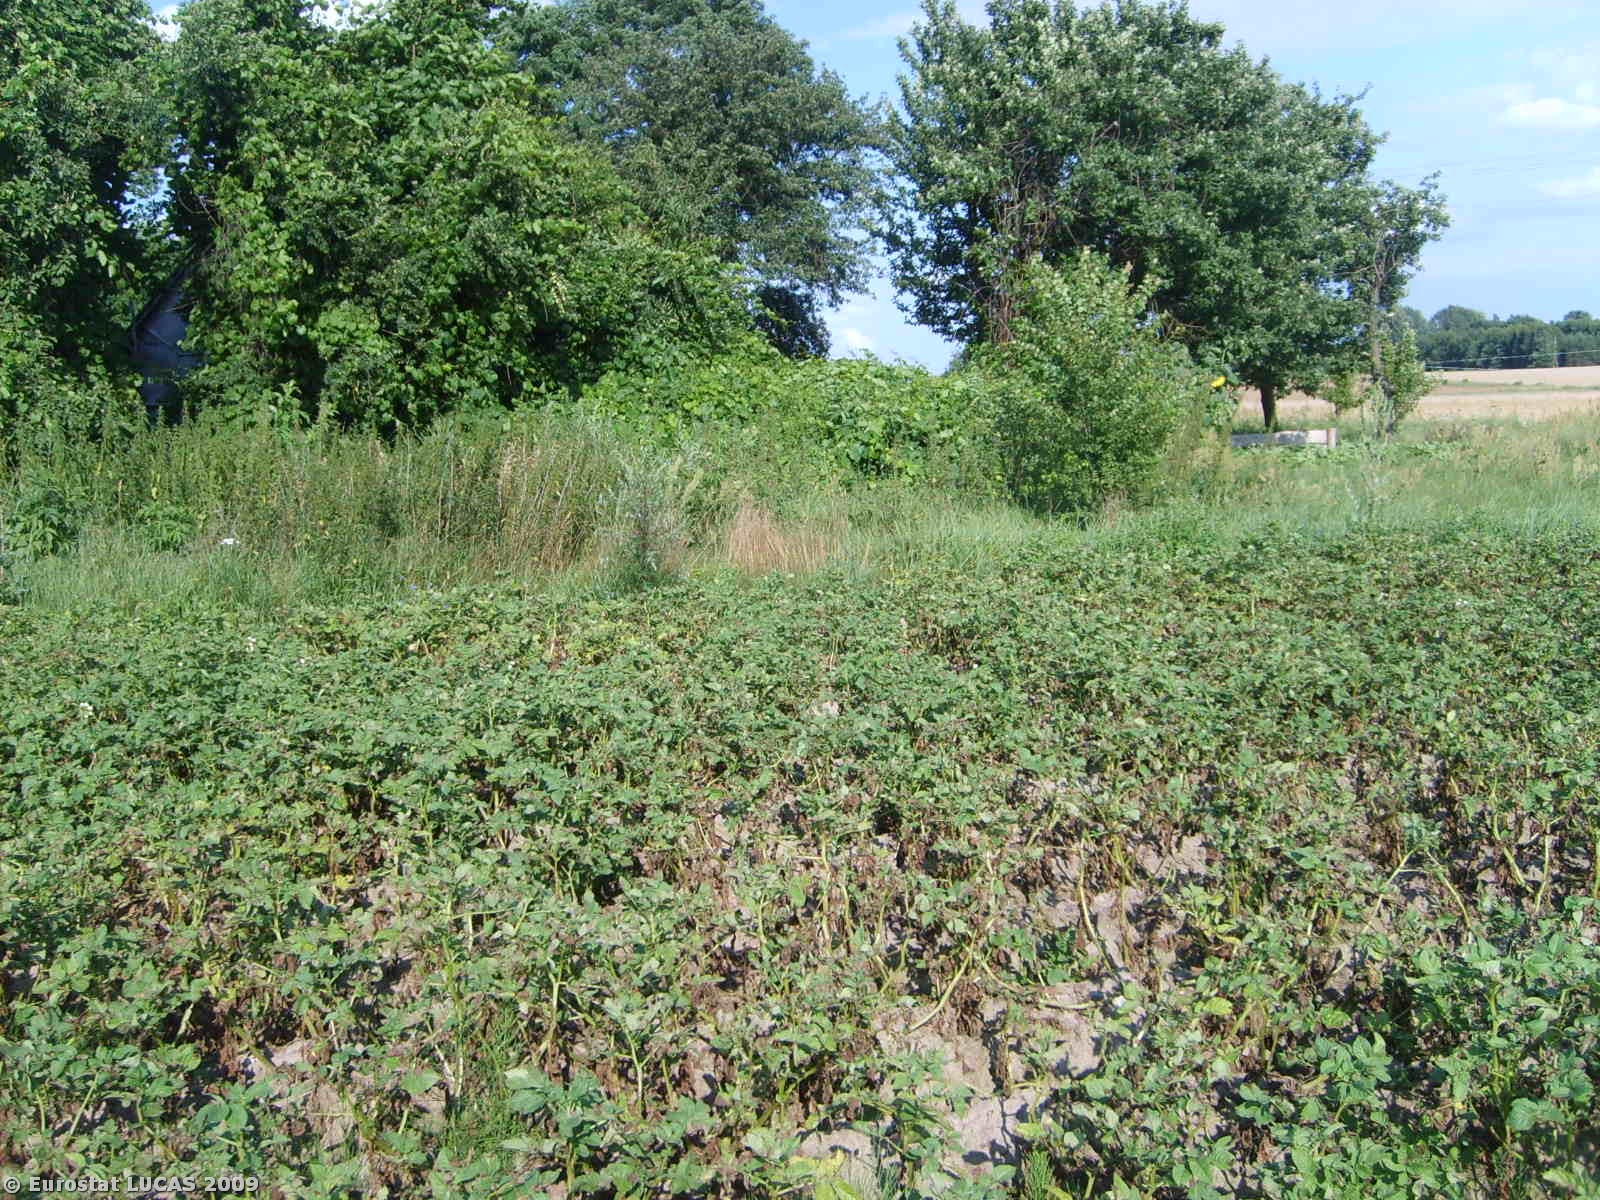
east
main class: Cropland
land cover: Potatoes
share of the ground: 50 - 75 %
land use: Agriculture (excluding fallow land and kitchen gardens)
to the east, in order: Potatoes; Grass margins; Grassland with sparse tree/shrub cover; Grass margins; Tracks; Grass margins; Shrubland with sparse tree cover; Artificial constructions in urban areas; Grass margins; Tracks; Grass margins; Shrubland with sparse tree cover; Other fruit trees and berries; Electric lines; Other fruit trees and berries; Grass margins; Paved roads, cycling and walking lanes; Grass margins; Triticale; Grass margins; Mixed cereals for fodder; Grass margins; Paved roads, cycling and walking lanes; Grass margins; Potatoes; Other fruit trees and berries; Grass margins; Grassland without tree/shrub cover; Grass margins; Barley
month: July
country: PL
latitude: 51.5996
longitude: 22.0272
